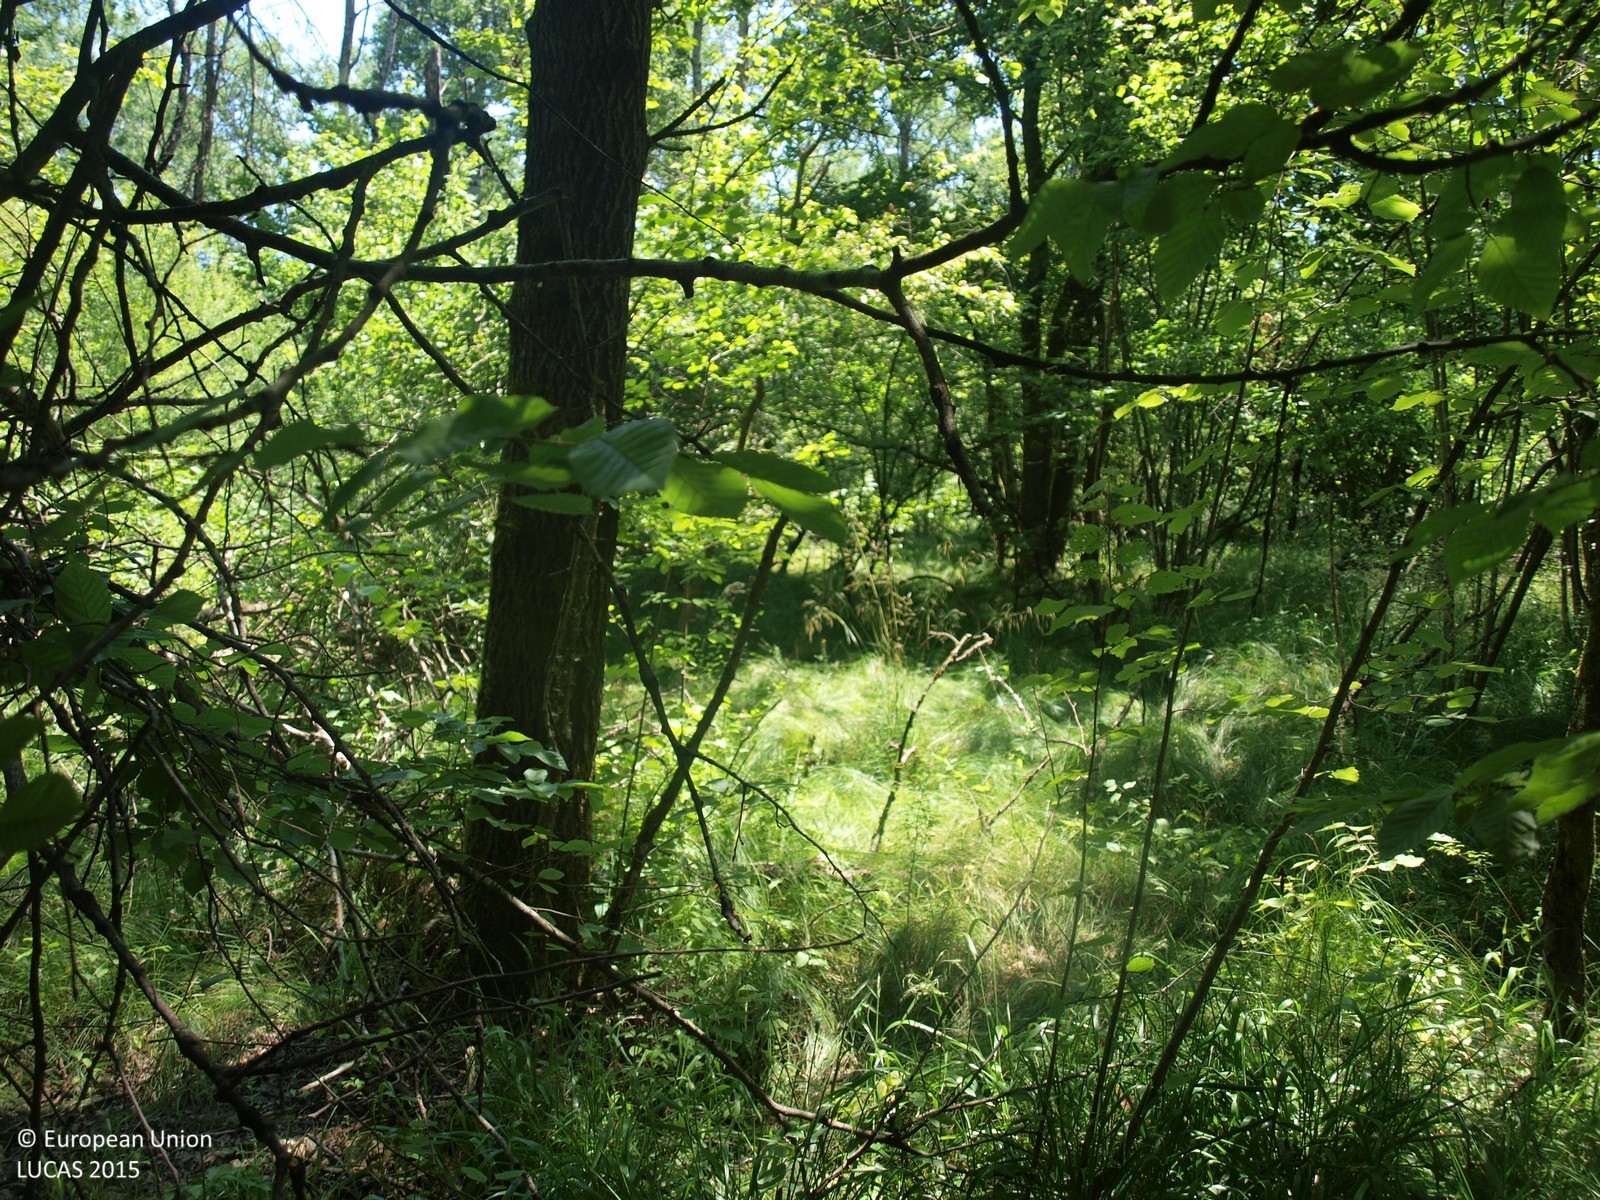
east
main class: Woodland
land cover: Broadleaved woodland
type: floodplain forest
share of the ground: > 75 %
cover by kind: broadleaved forest trees 100 %
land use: Forestry
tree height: > 5 m
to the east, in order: Broadleaved woodland; Ditches and canals; Tracks; Ditches and canals; Broadleaved woodland
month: July
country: HR
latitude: 45.6405
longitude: 15.6804
